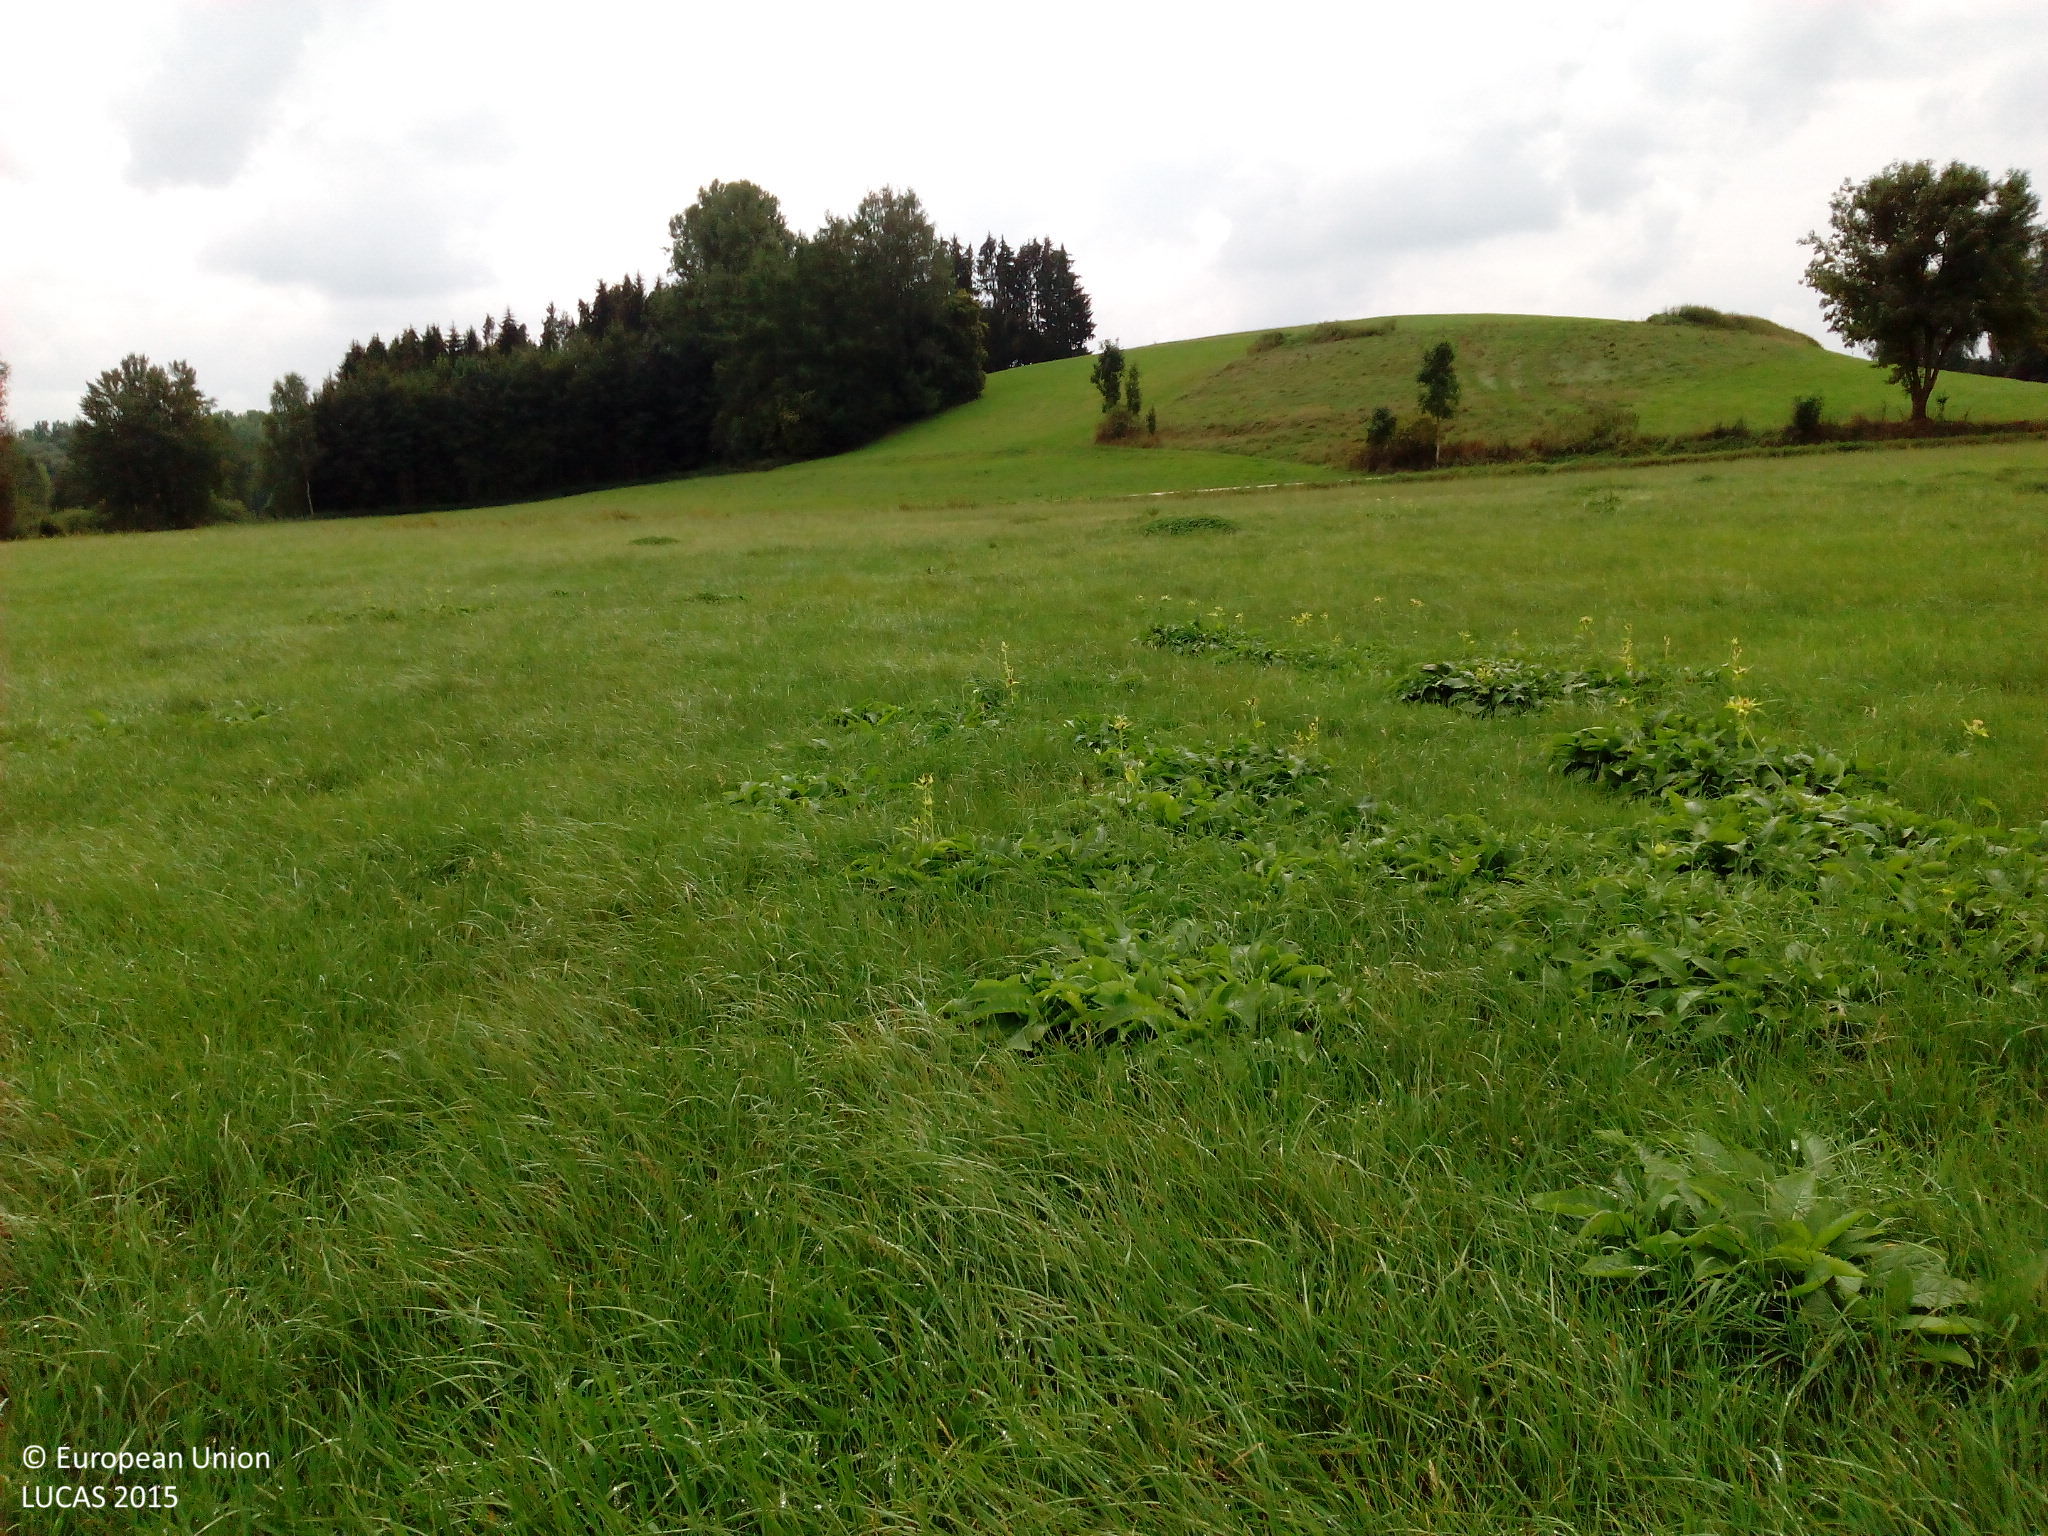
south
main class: Grassland
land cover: Grassland without tree/shrub cover
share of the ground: > 75 %
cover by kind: herbaceous plants 100 %
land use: Agriculture (excluding fallow land and kitchen gardens)
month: September
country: DE
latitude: 48.3311
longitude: 10.3101
